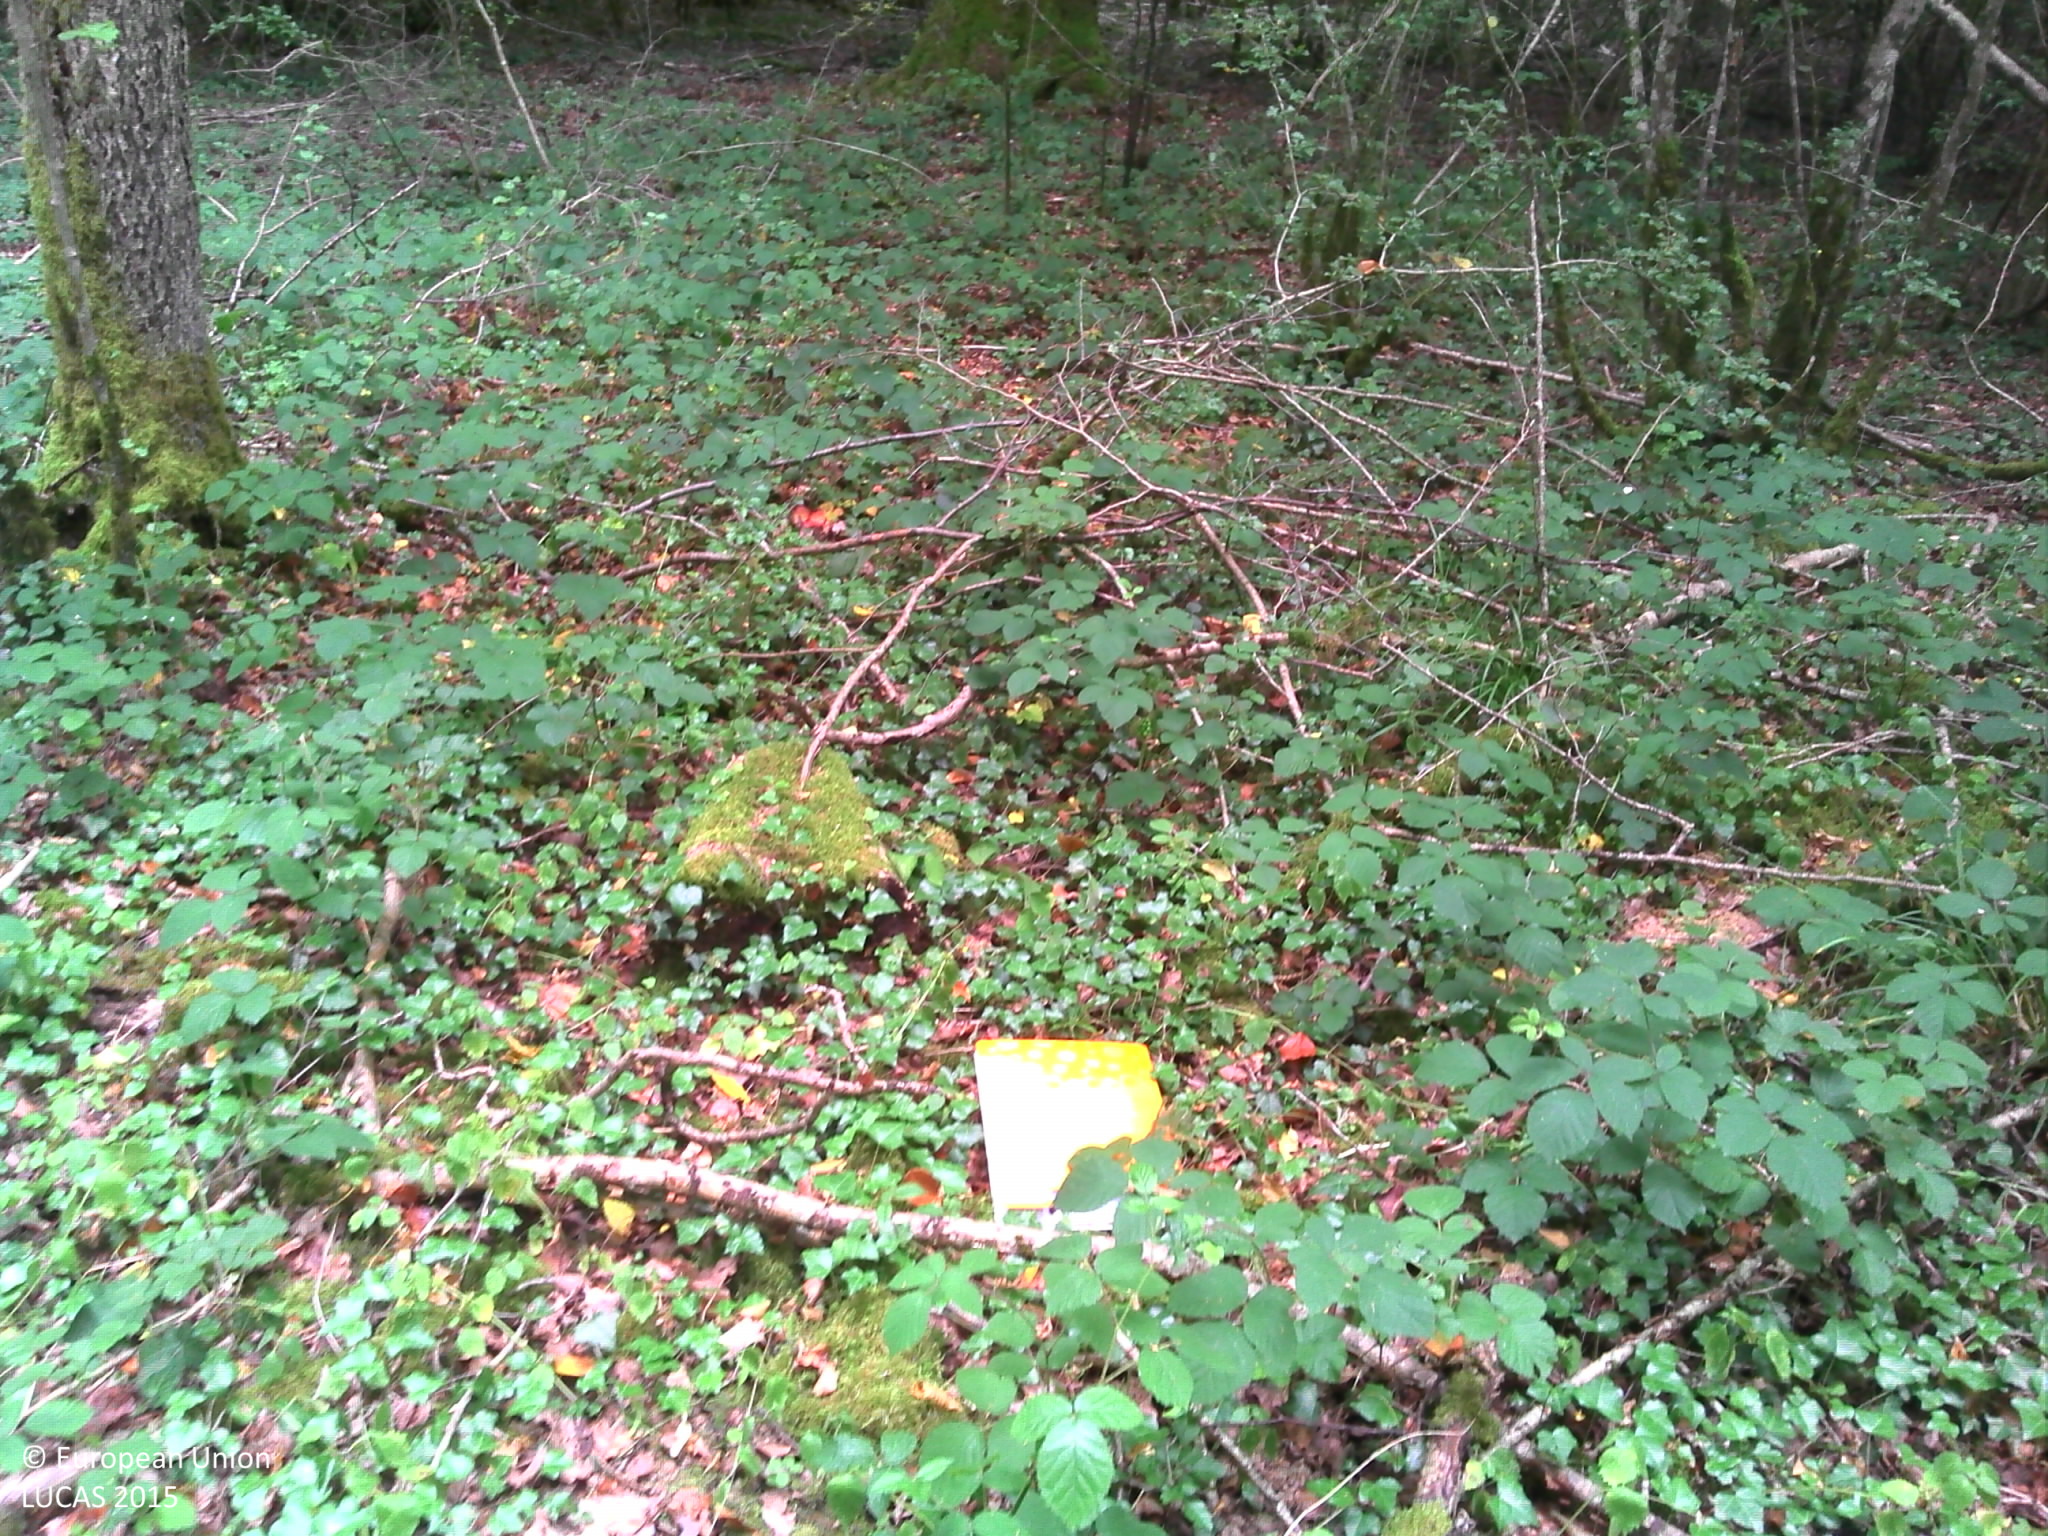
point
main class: Woodland
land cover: Broadleaved woodland
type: mesophytic deciduous forest
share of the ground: > 75 %
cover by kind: broadleaved forest trees 85 %, herbaceous plants 10 %, lichens and mosses 5 %
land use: Forestry
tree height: > 5 m
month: July
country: FR
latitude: 48.1468
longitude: 5.0125
